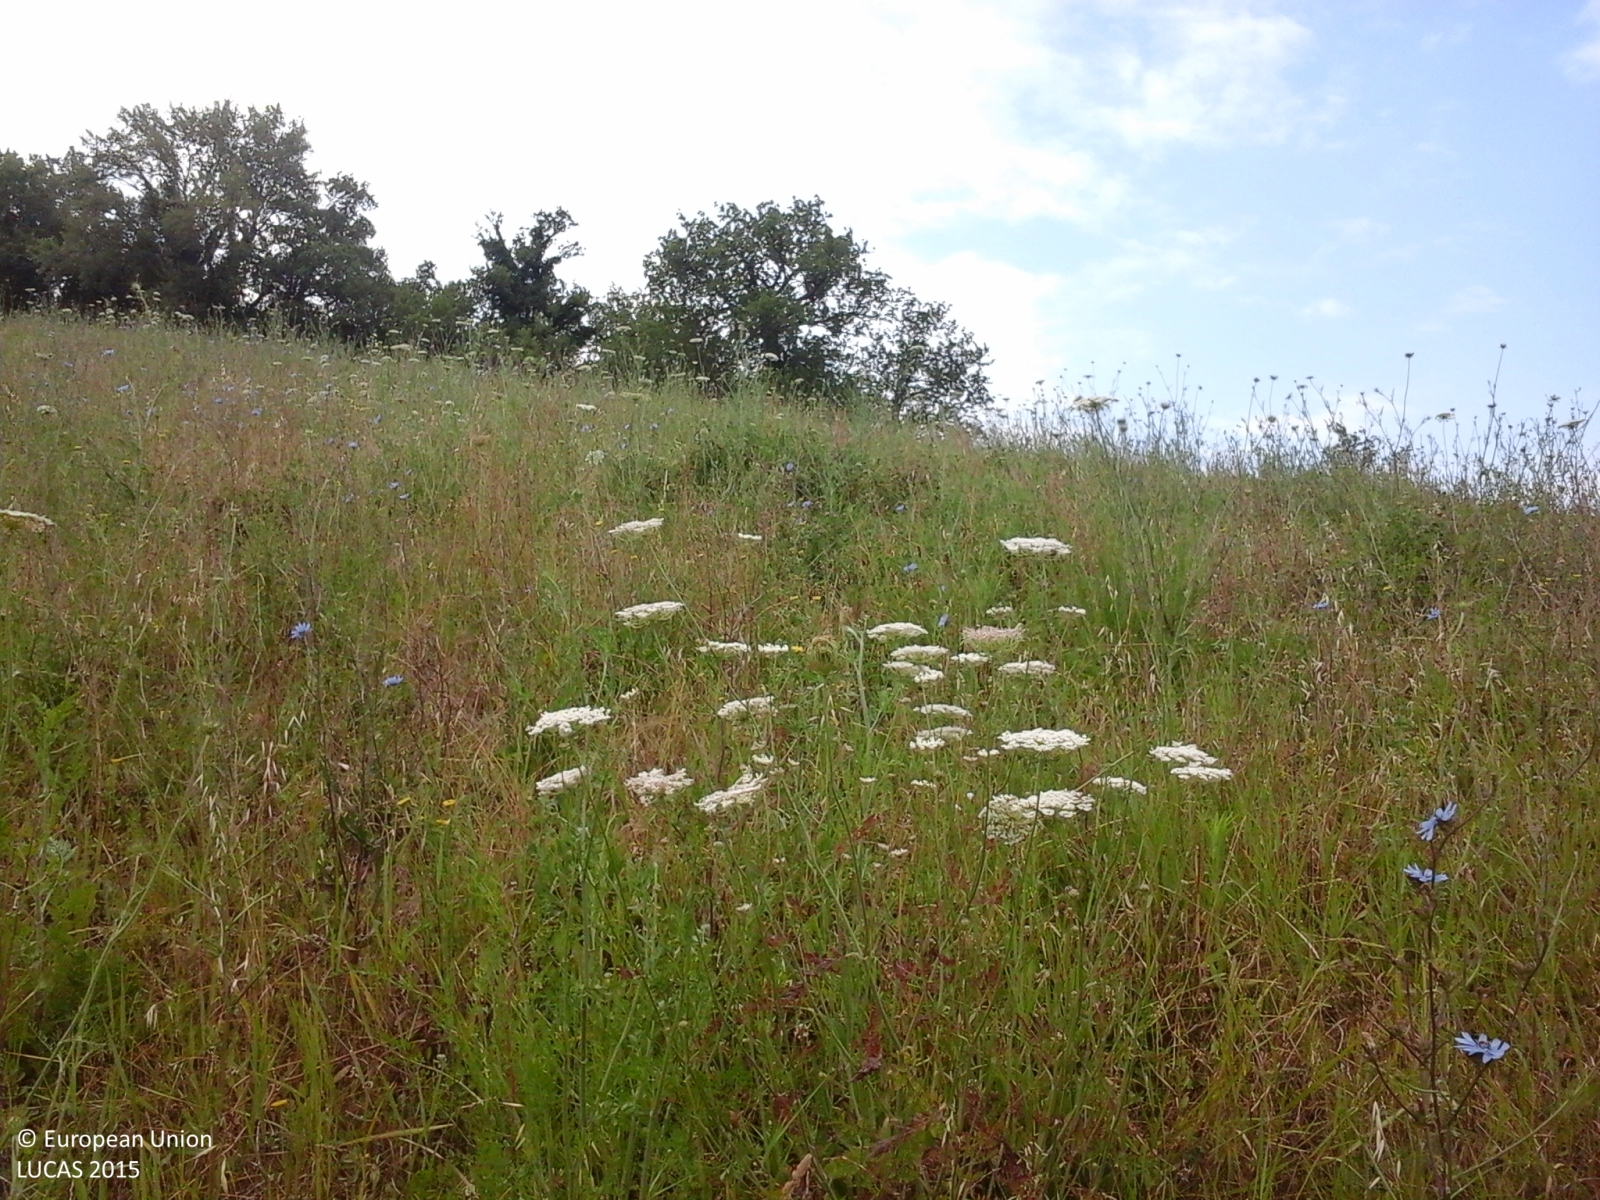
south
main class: Grassland
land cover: Spontaneously vegetated surfaces
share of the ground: > 75 %
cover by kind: herbaceous plants 95 %, shrubs 5 %
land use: Agriculture (excluding fallow land and kitchen gardens)
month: June
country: IT
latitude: 43.1997
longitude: 13.2034
